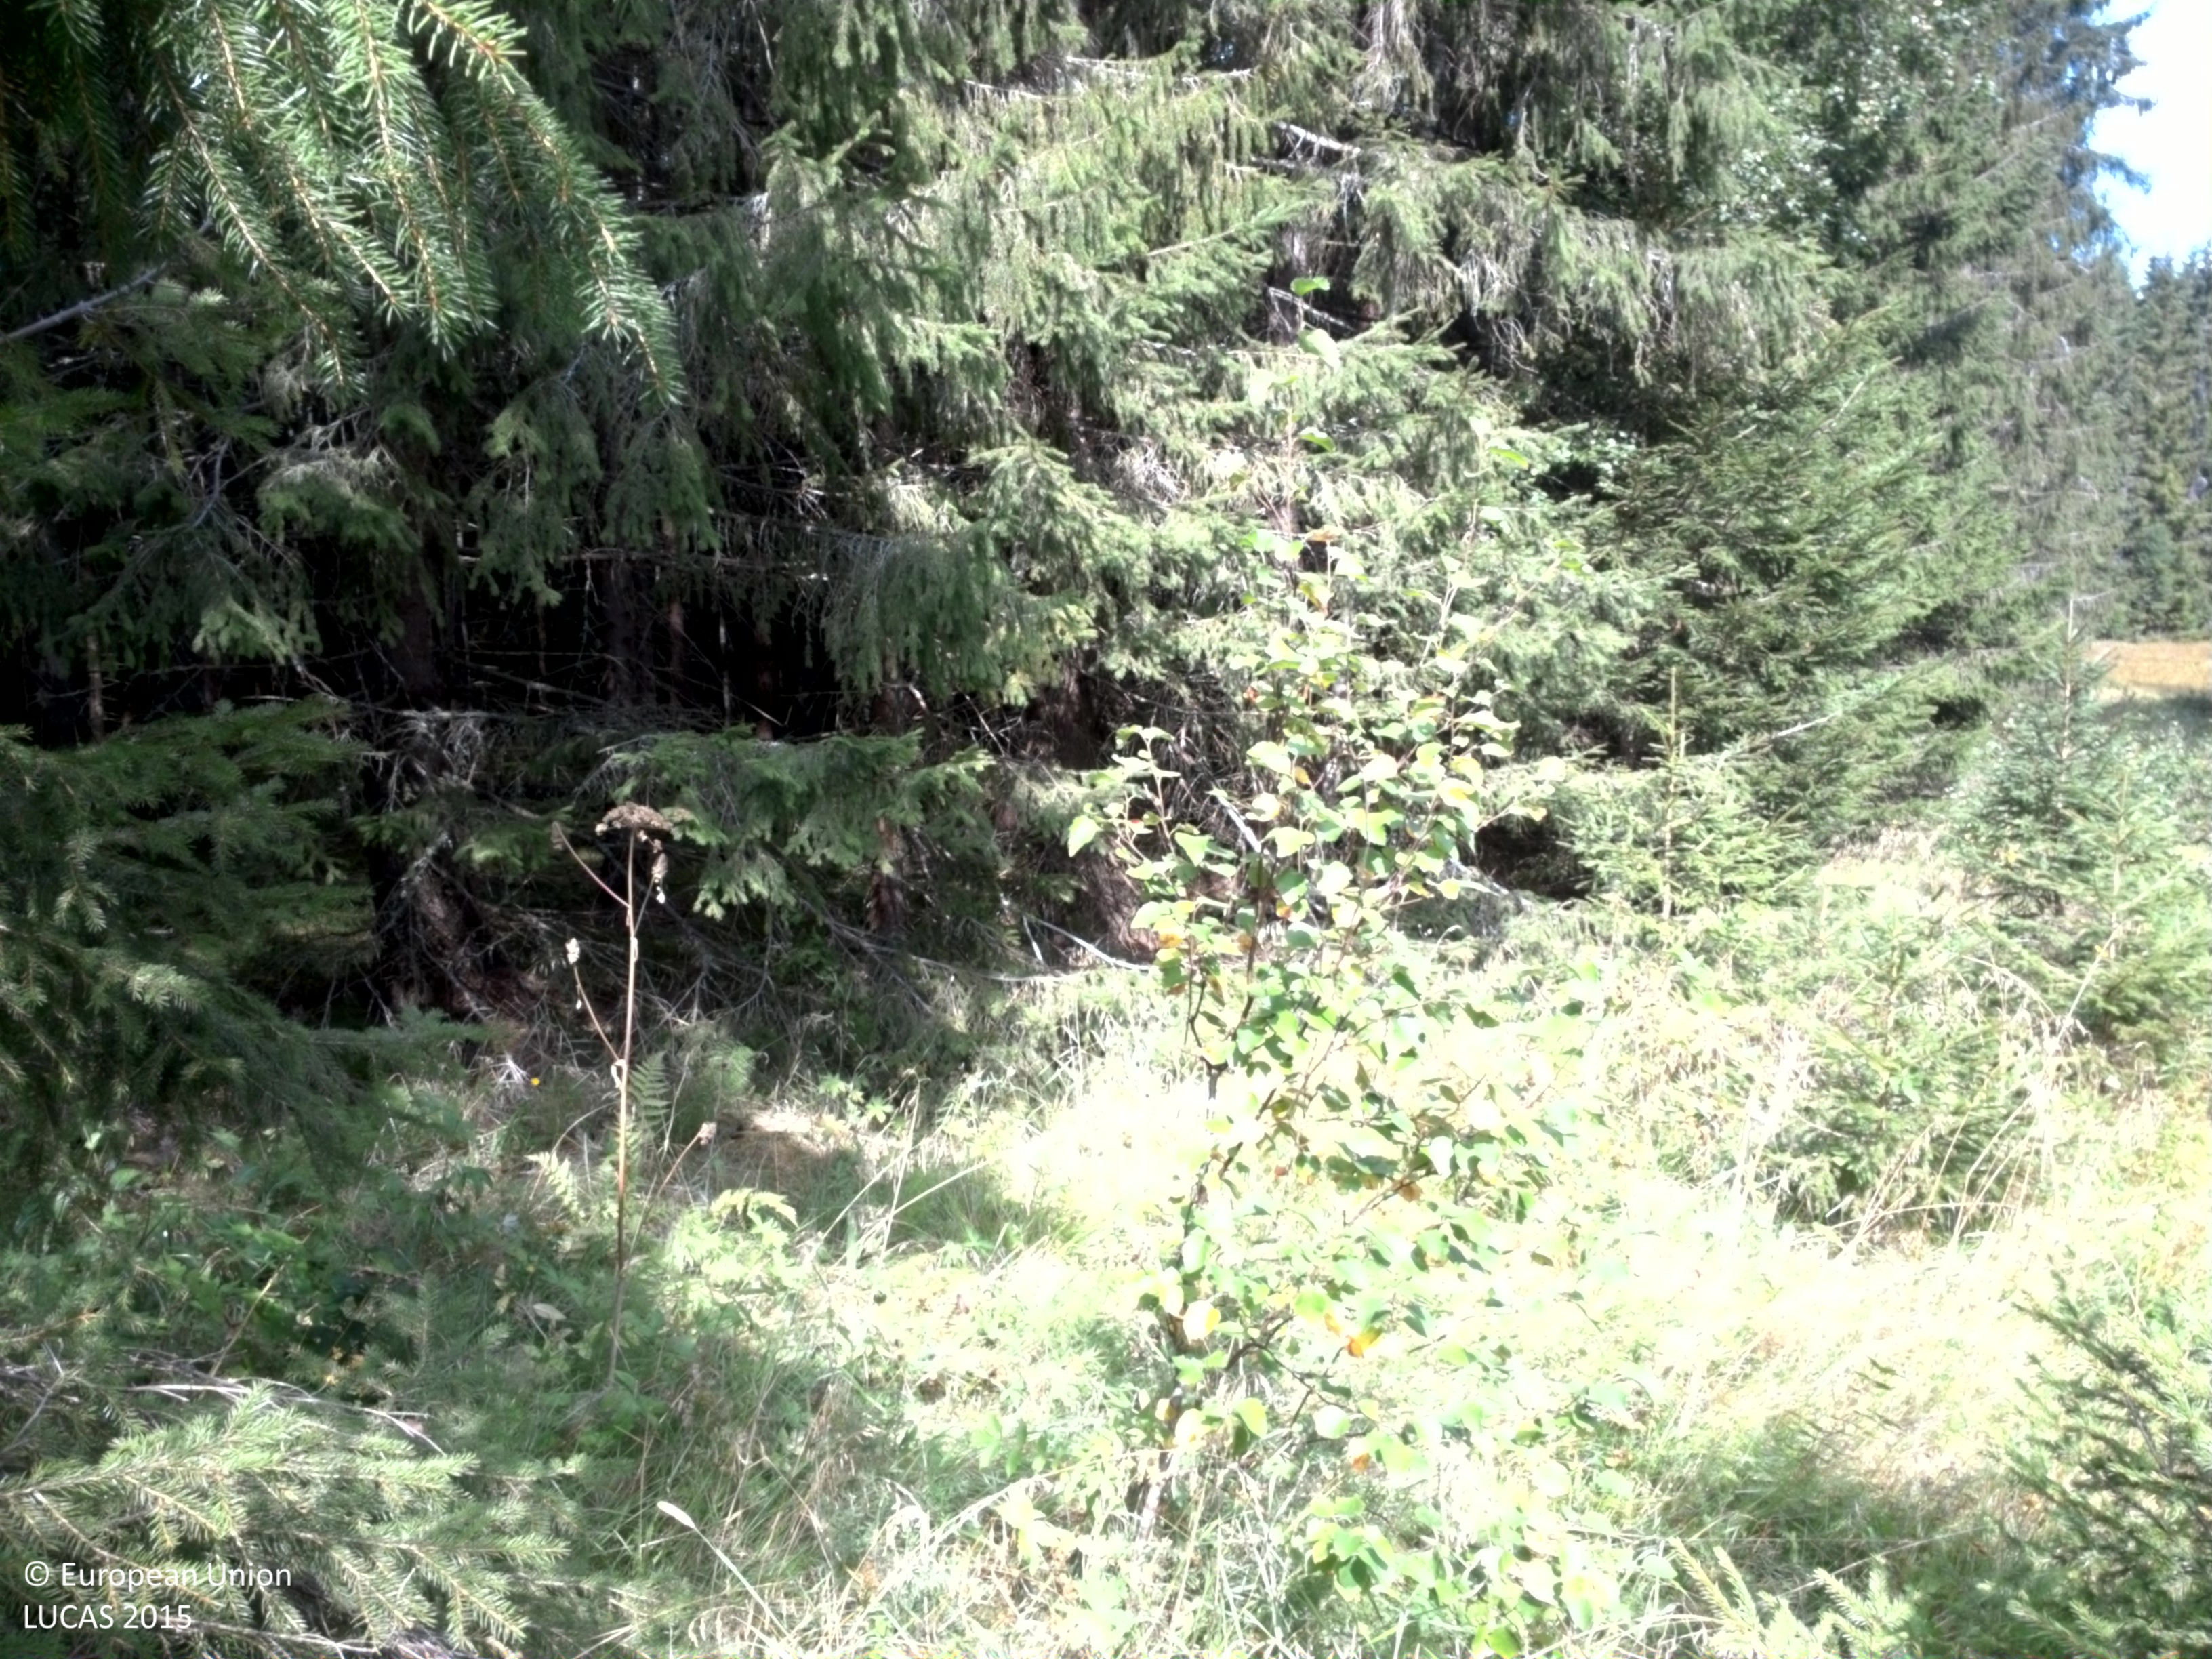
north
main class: Woodland
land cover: Spruce dominated mixed woodland
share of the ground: 25 - 50 %
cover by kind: herbaceous plants 70 %, broadleaved forest trees 20 %, coniferous forest trees 10 %
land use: Forestry
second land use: Amenities, museums, leisure
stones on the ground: < 10 %
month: August
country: SE
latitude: 59.7899
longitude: 15.8167
